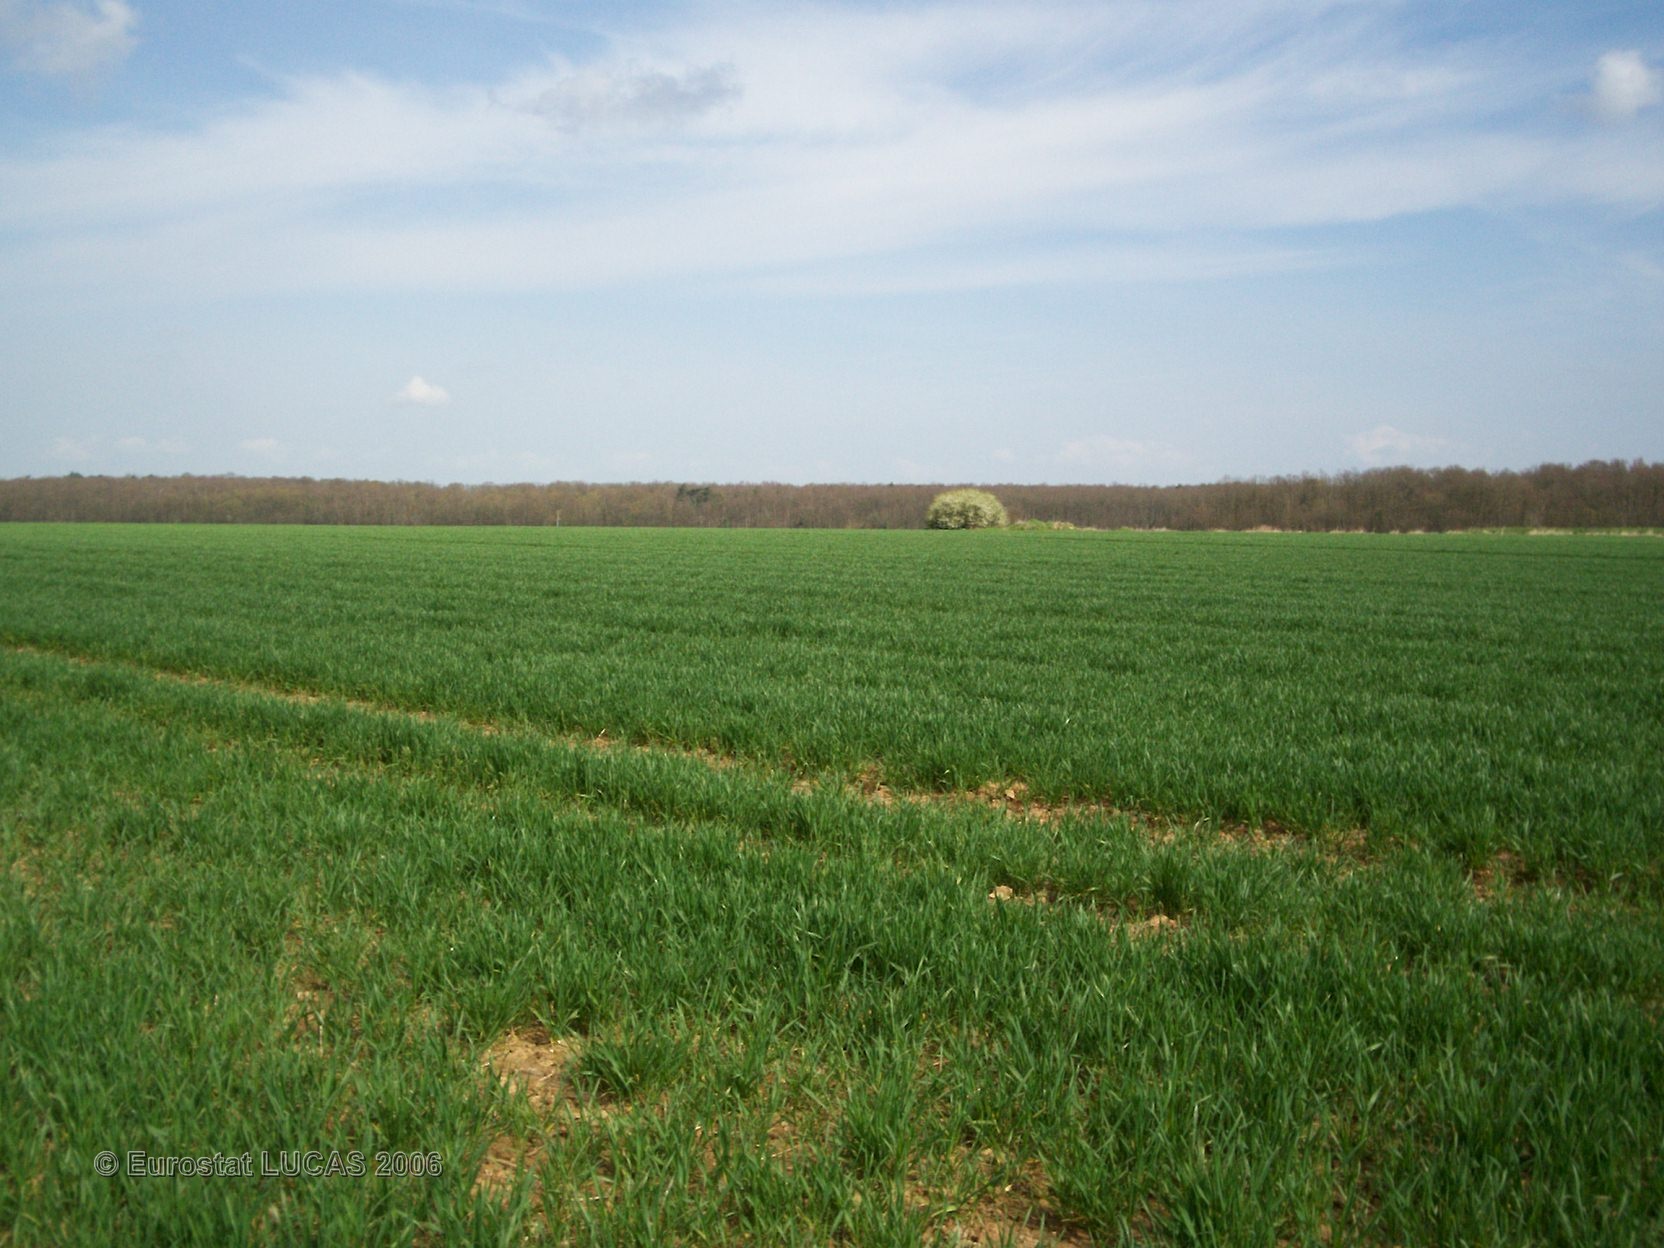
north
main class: Cropland
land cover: Common wheat
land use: Agriculture (excluding fallow land and kitchen gardens)
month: April
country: FR
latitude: 48.9973
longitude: 1.0260
